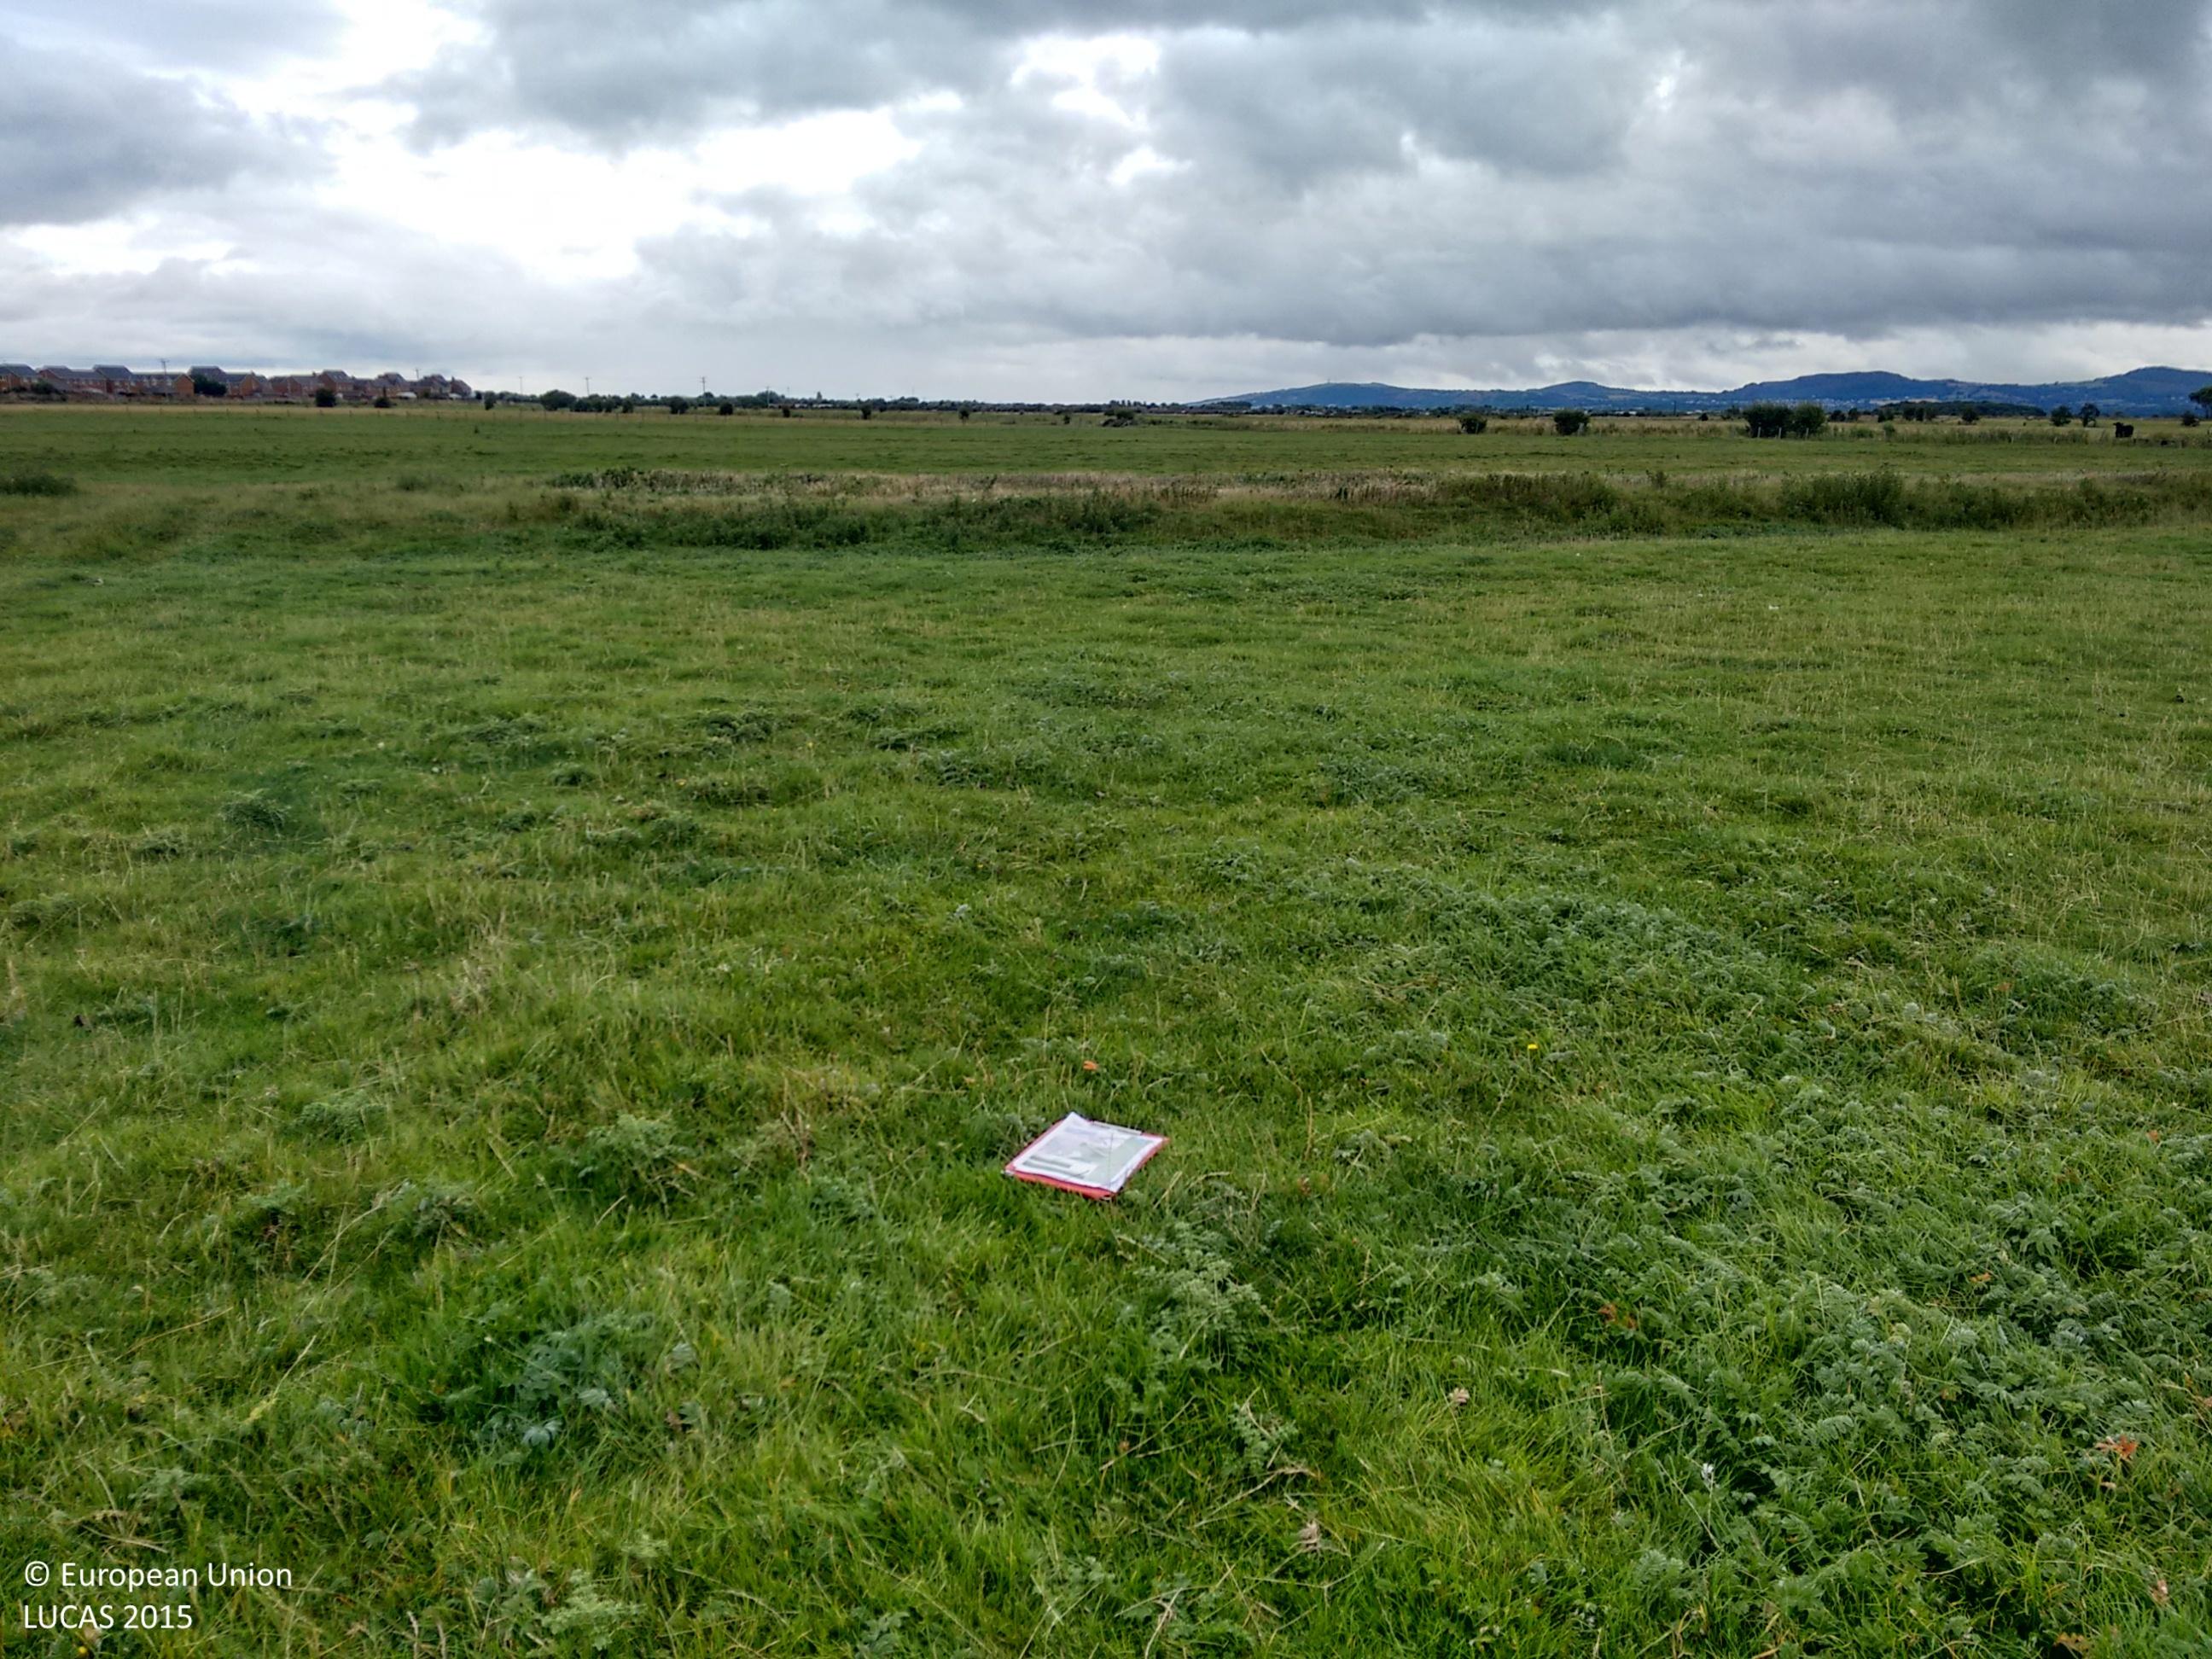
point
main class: Grassland
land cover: Grassland without tree/shrub cover
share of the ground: > 75 %
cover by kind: herbaceous plants 100 %
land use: Agriculture (excluding fallow land and kitchen gardens)
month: August
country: GB
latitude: 53.2900
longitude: -3.5715
